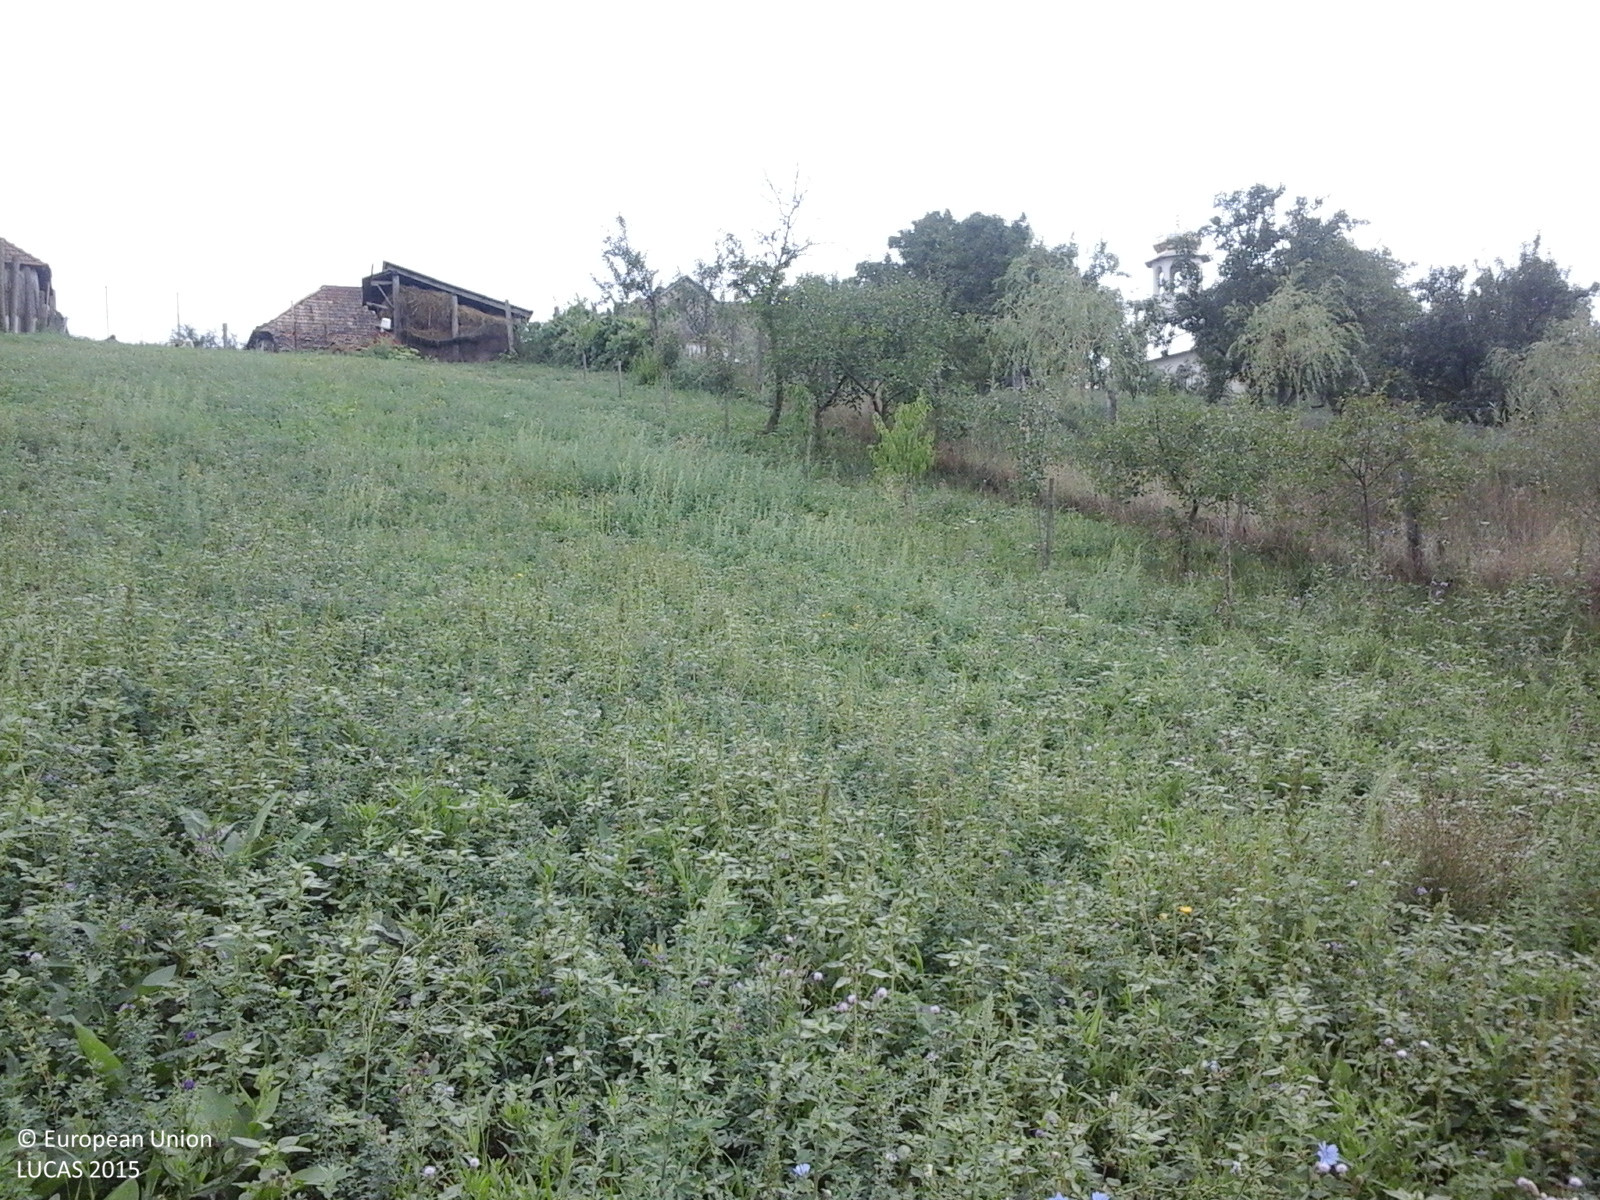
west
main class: Cropland
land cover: Lucerne
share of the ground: > 75 %
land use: Agriculture (excluding fallow land and kitchen gardens)
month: August
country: RO
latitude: 45.9672
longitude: 21.4813
